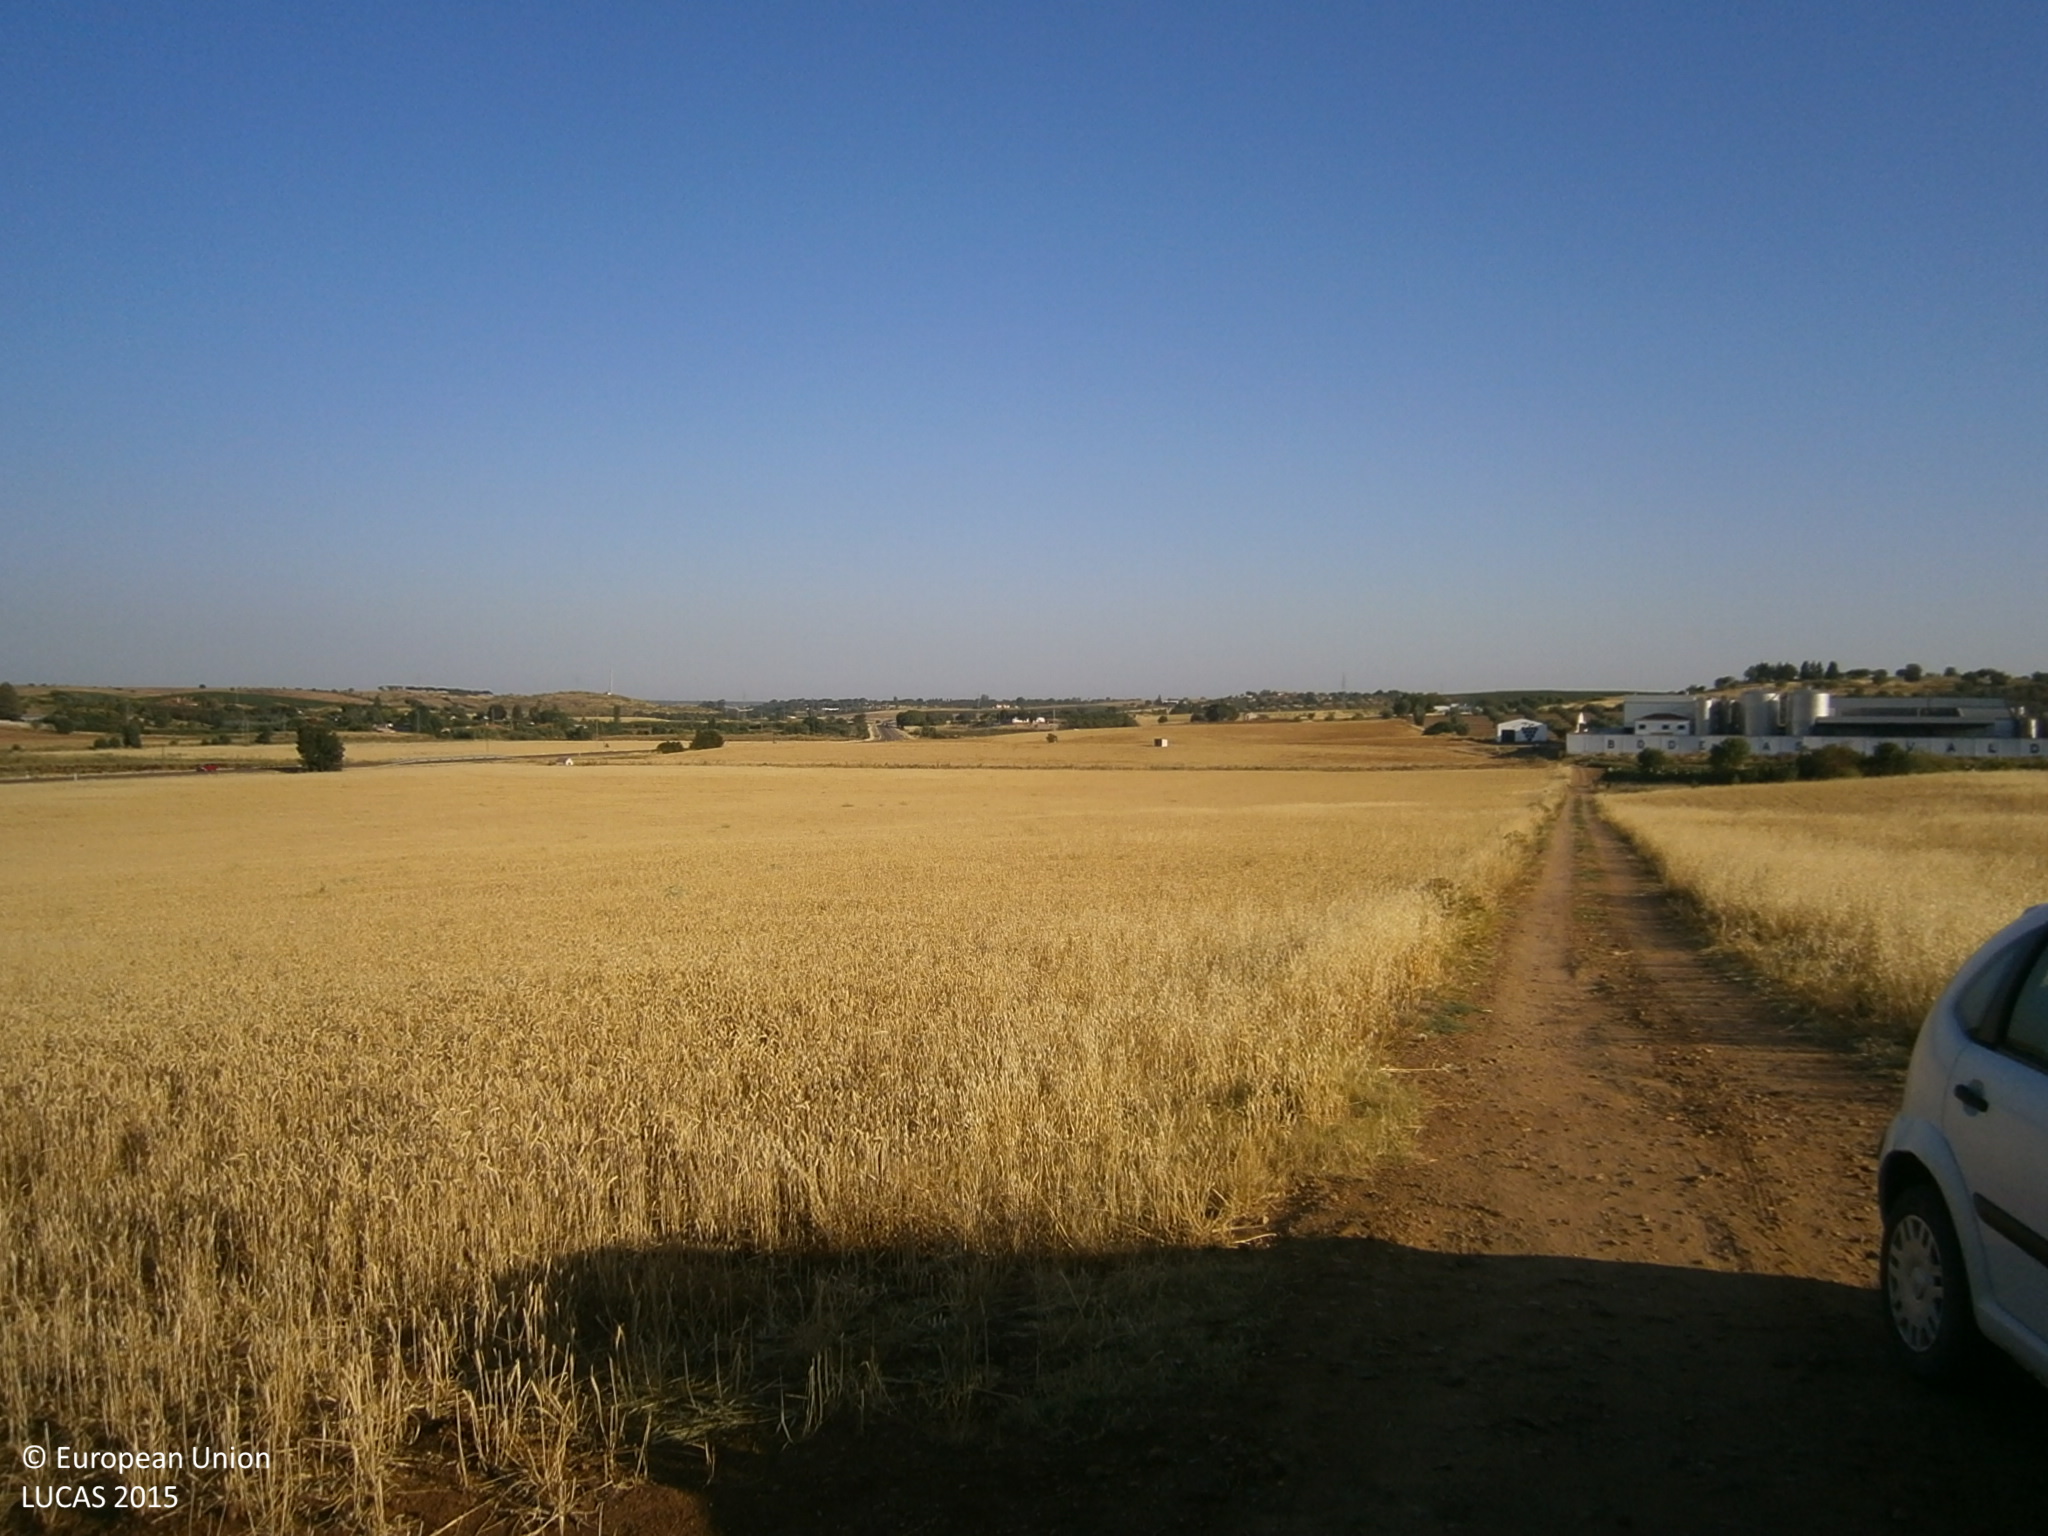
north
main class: Cropland
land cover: Nuts trees
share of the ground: 10 - 25 %
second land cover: Spontaneously vegetated surfaces
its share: 50 - 75 %
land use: Agriculture (excluding fallow land and kitchen gardens)
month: June
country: ES
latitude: 38.7955
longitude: -6.8644
